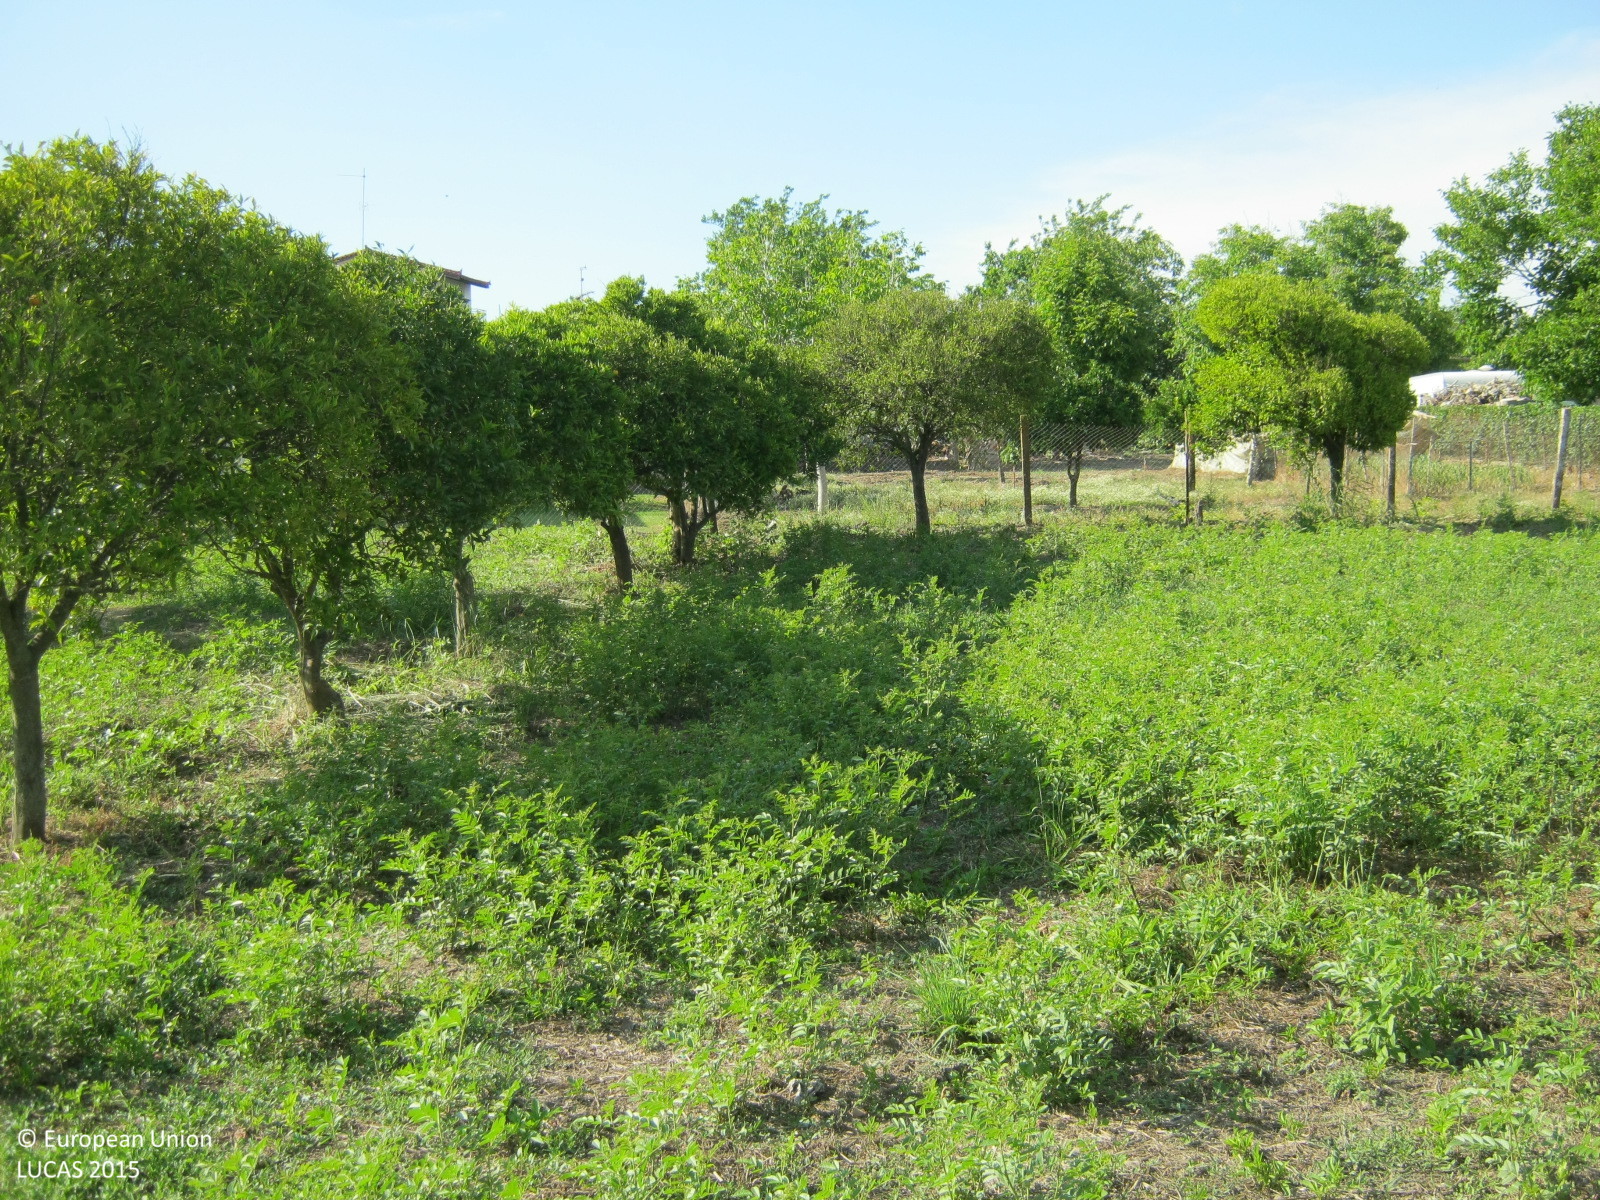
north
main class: Cropland
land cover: Oranges
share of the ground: 10 - 25 %
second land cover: Spontaneously vegetated surfaces
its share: > 75 %
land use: Kitchen garden
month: May
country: GR
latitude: 37.8466
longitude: 21.2446
